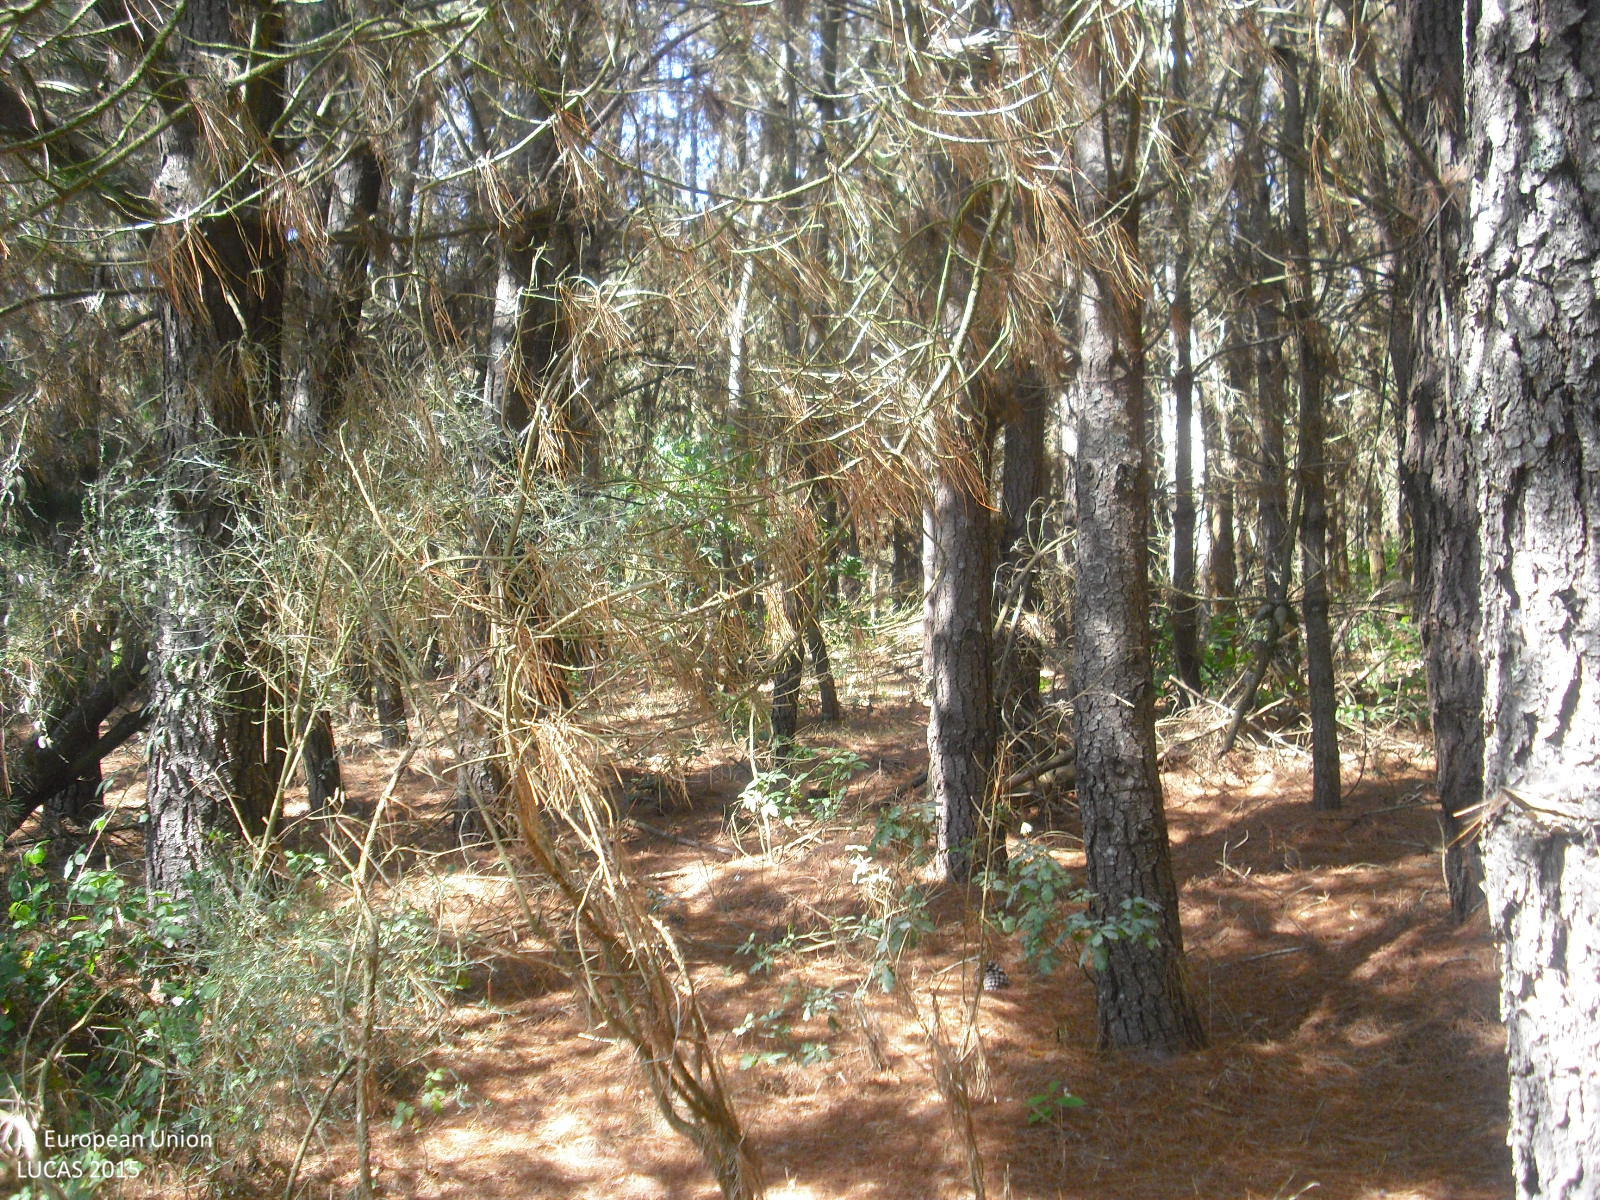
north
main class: Shrubland
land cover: Shrubland with sparse tree cover
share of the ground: > 75 %
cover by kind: shrubs 95 %, broadleaved forest trees 5 %
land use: Abandoned areas
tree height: < 5 m
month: July
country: ES
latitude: 42.6555
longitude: -7.5535
